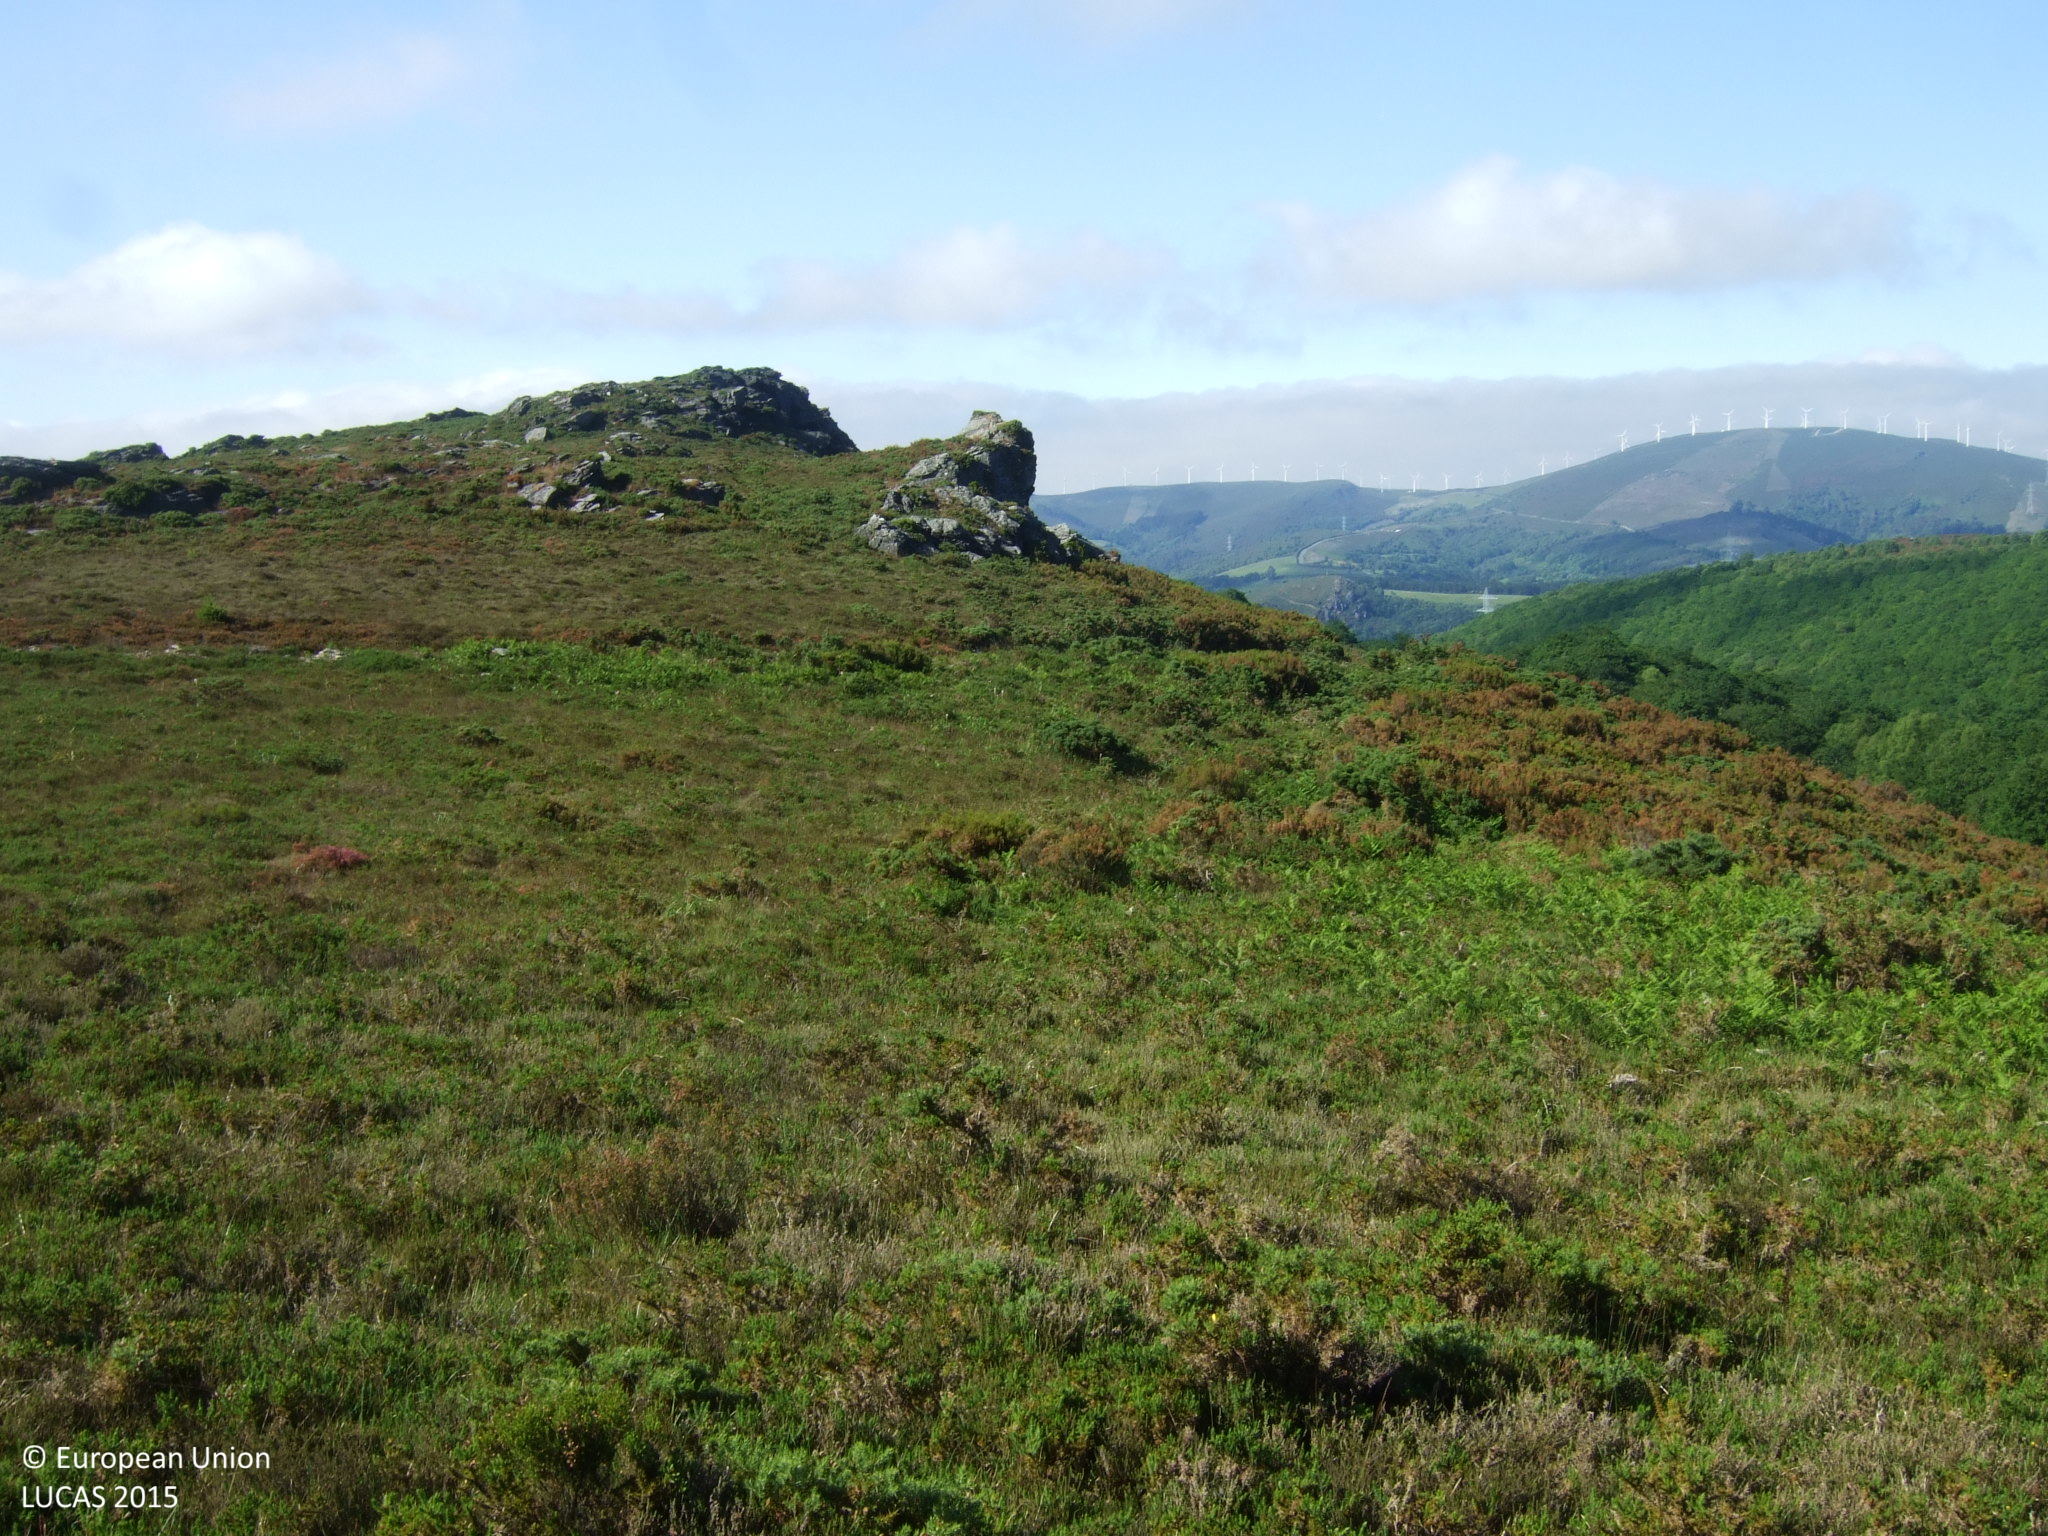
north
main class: Shrubland
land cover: Shrubland without tree cover
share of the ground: > 75 %
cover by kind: shrubs 100 %
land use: Semi-natural and natural areas not in use
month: June
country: ES
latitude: 43.4510
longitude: -7.7469
